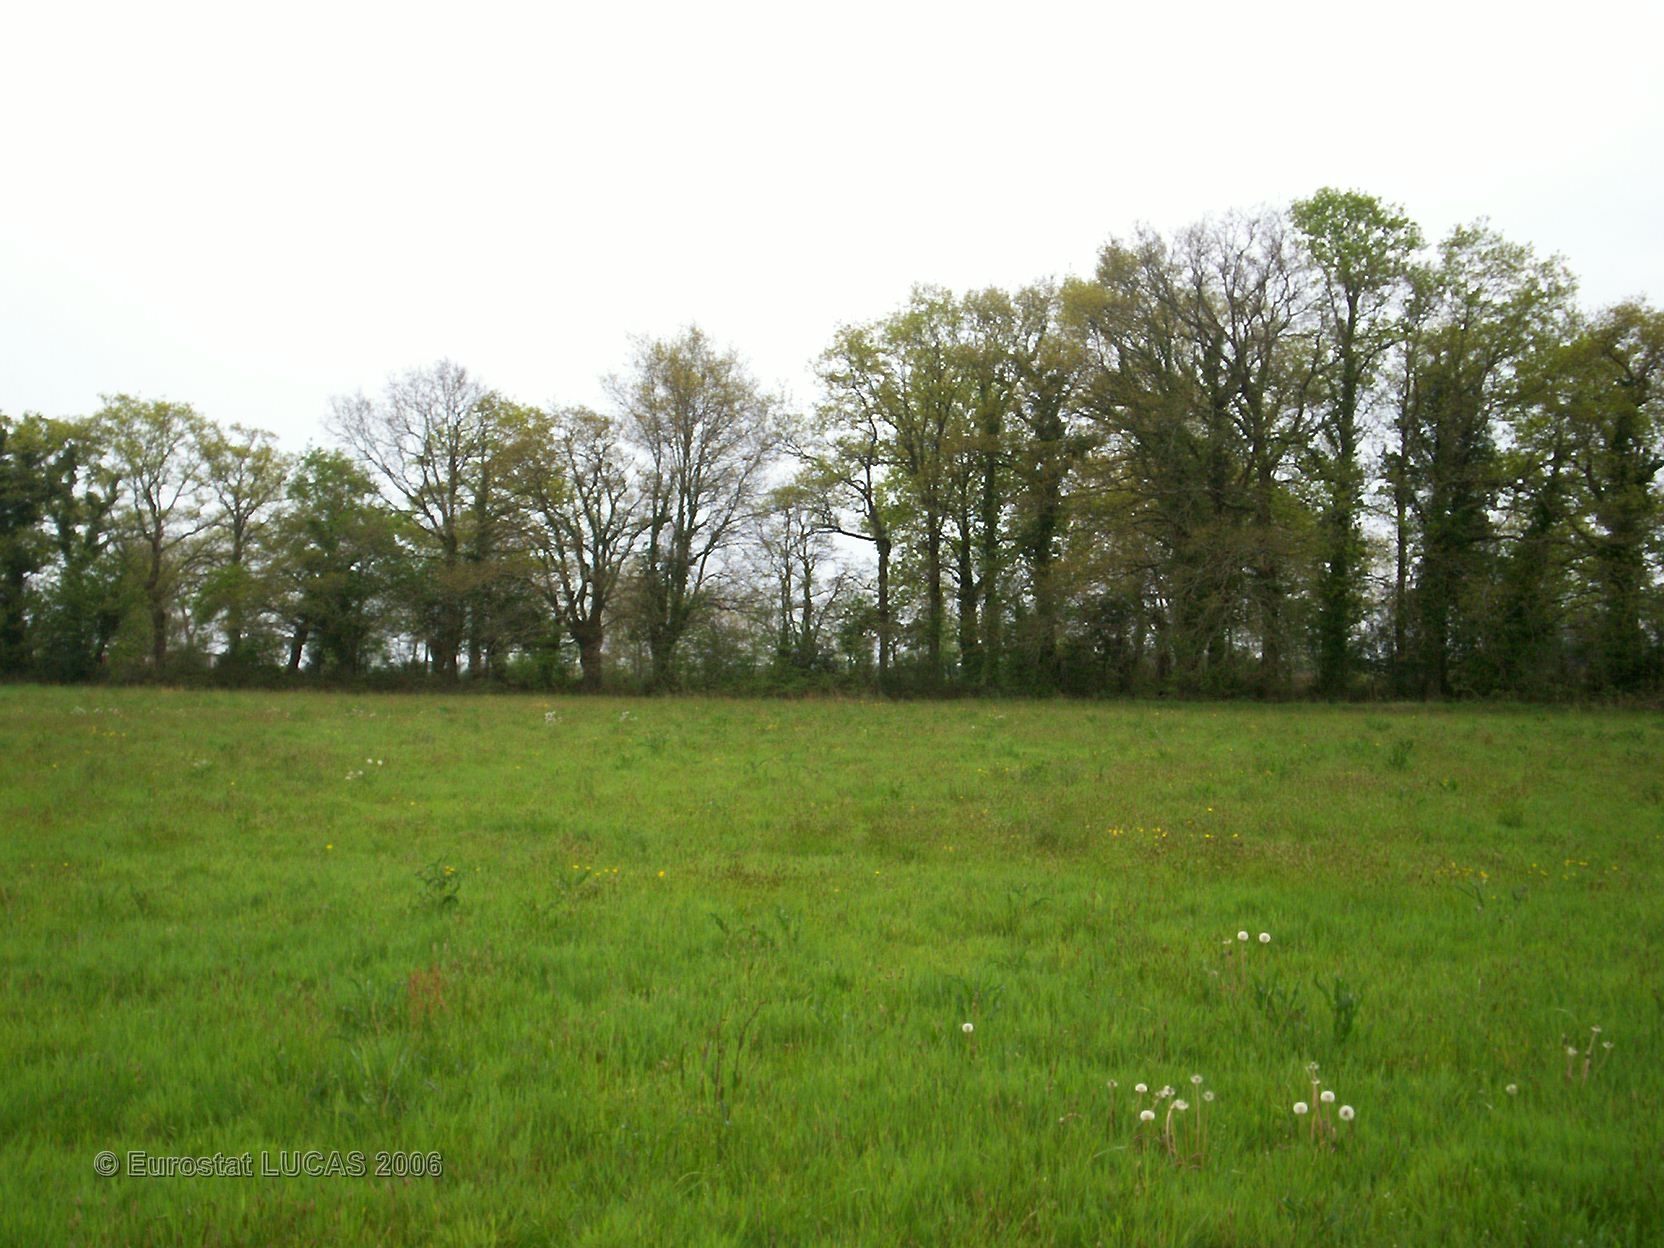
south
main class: Grassland
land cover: Grassland without tree/shrub cover
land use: Agriculture (excluding fallow land and kitchen gardens)
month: April
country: FR
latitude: 47.5823
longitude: -2.6511
